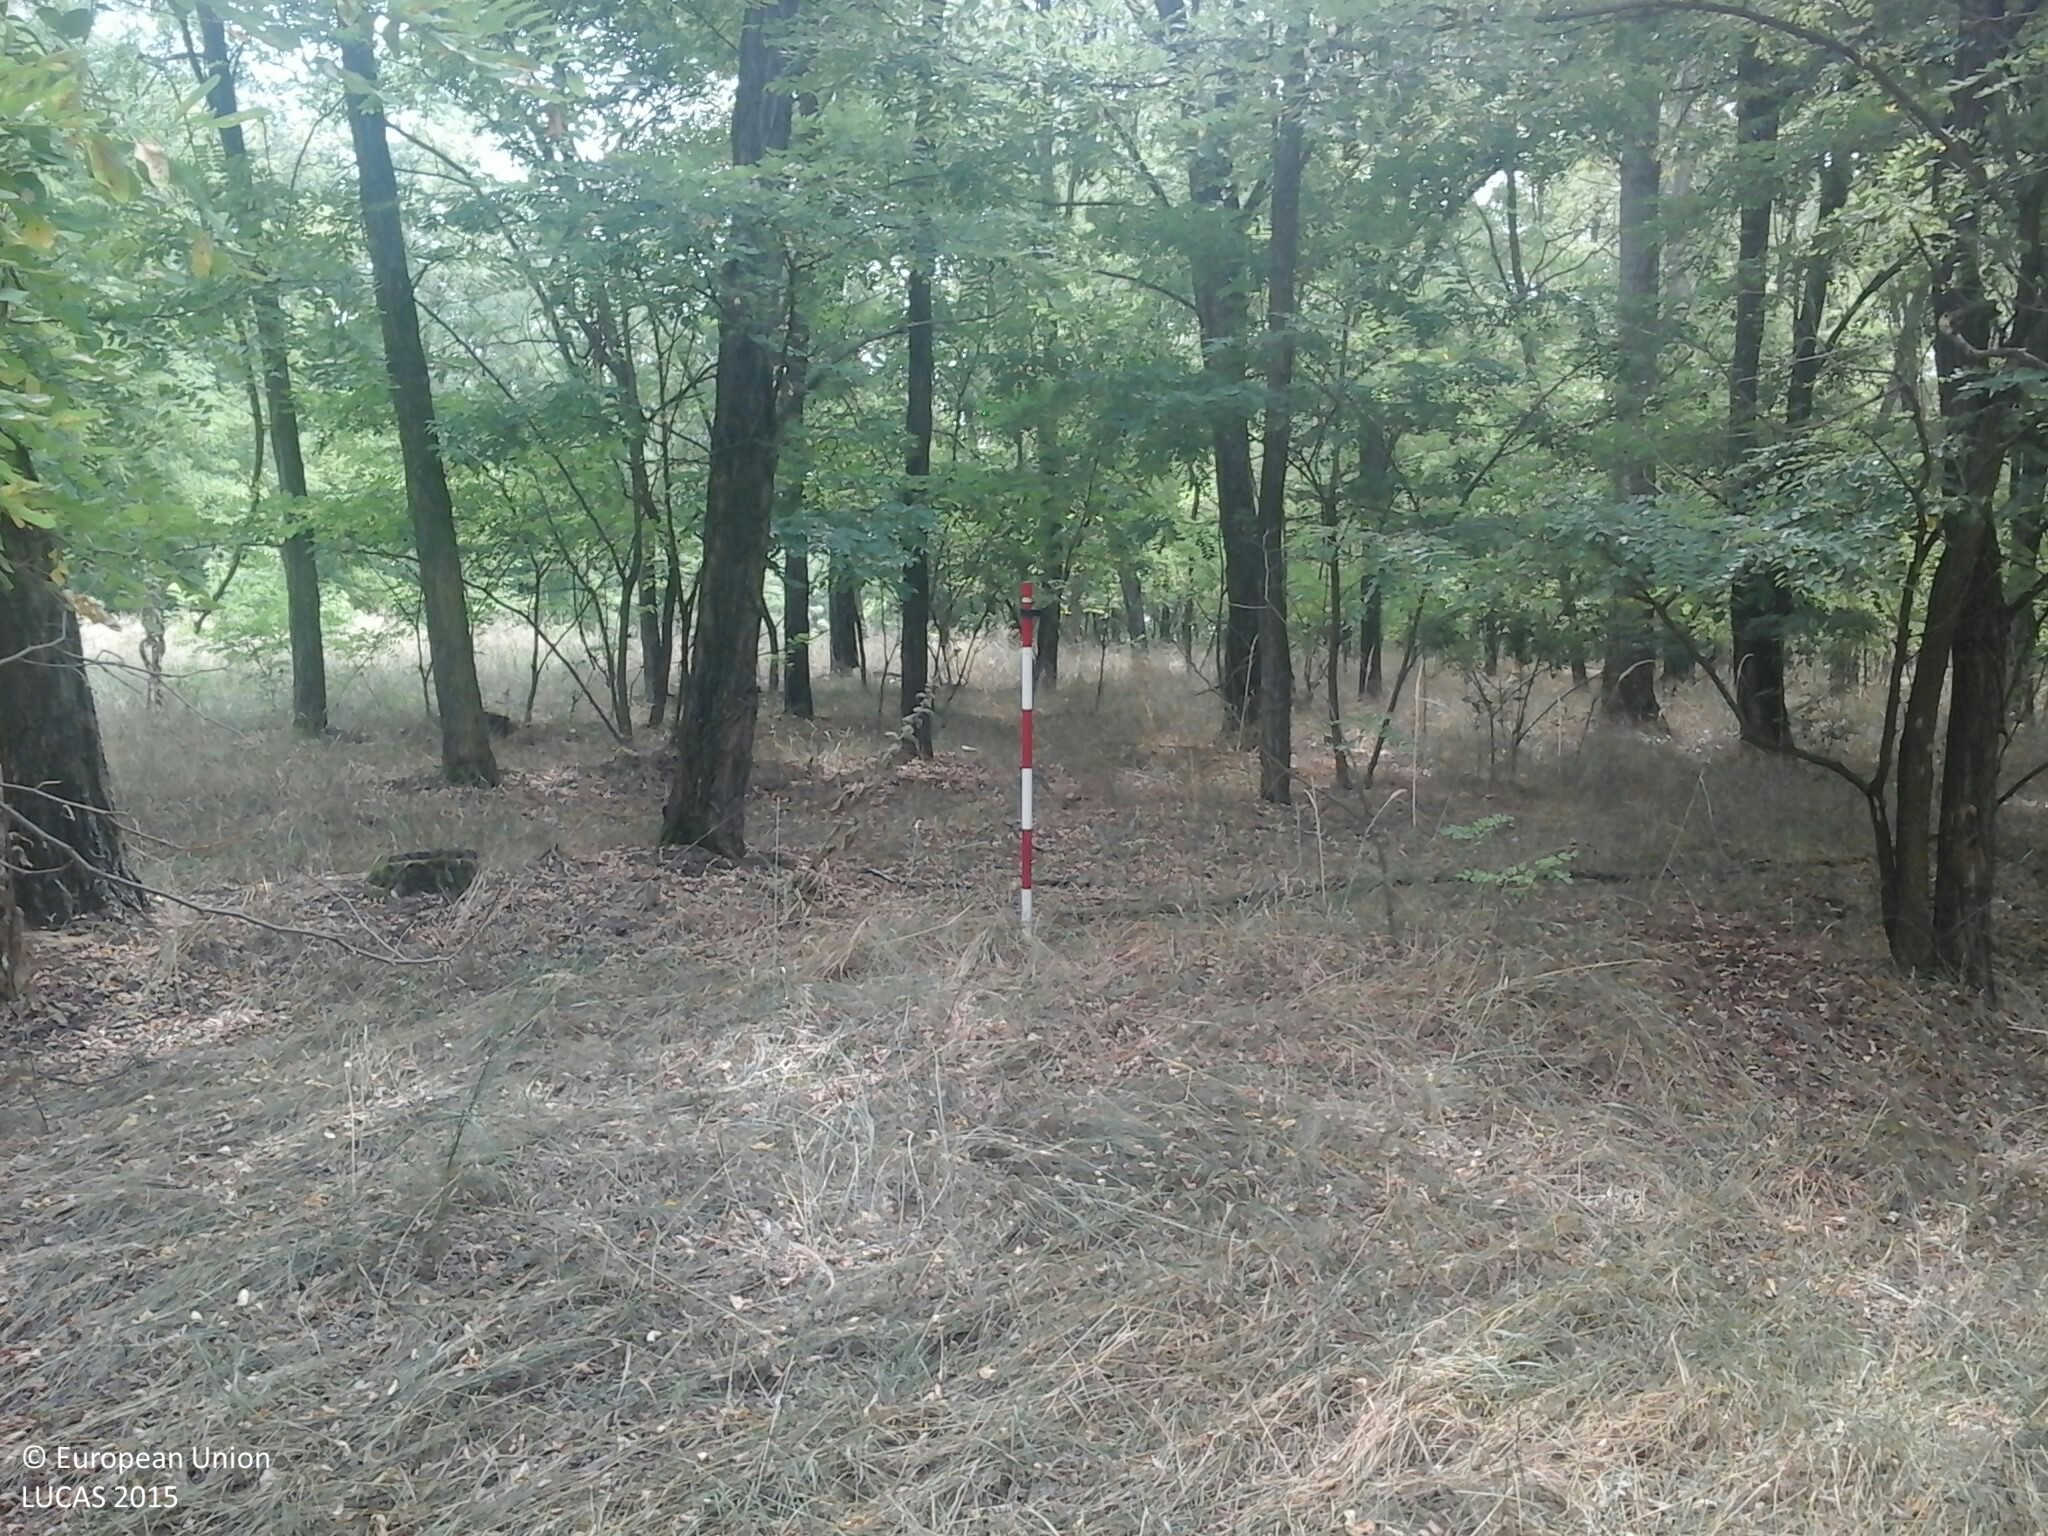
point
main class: Woodland
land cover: Broadleaved woodland
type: exotic forest
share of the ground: > 75 %
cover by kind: broadleaved forest trees 95 %, herbaceous plants 5 %
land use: Forestry
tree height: > 5 m
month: July
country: HU
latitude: 47.7546
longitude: 22.0980
